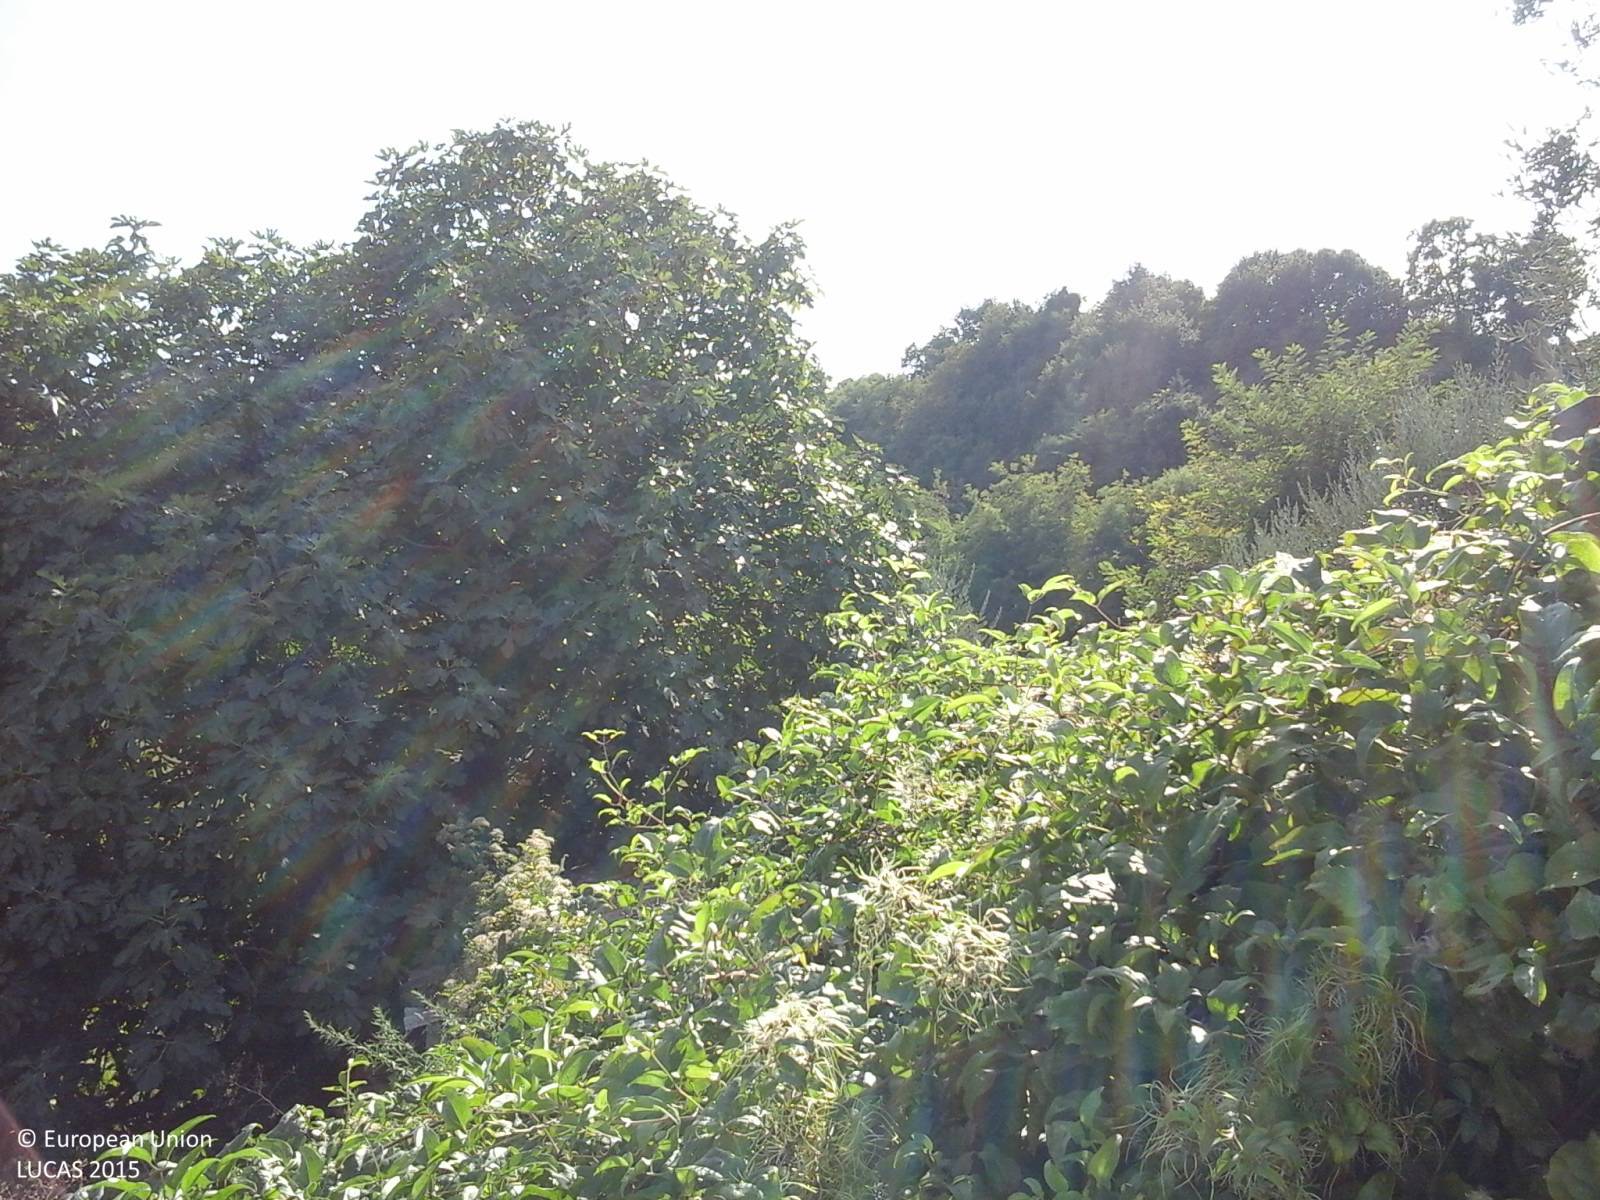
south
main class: Cropland
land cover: Vineyards
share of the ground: 50 - 75 %
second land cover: Grassland without tree/shrub cover
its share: > 75 %
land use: Agriculture (excluding fallow land and kitchen gardens)
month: September
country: IT
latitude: 42.6864
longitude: 12.1046
